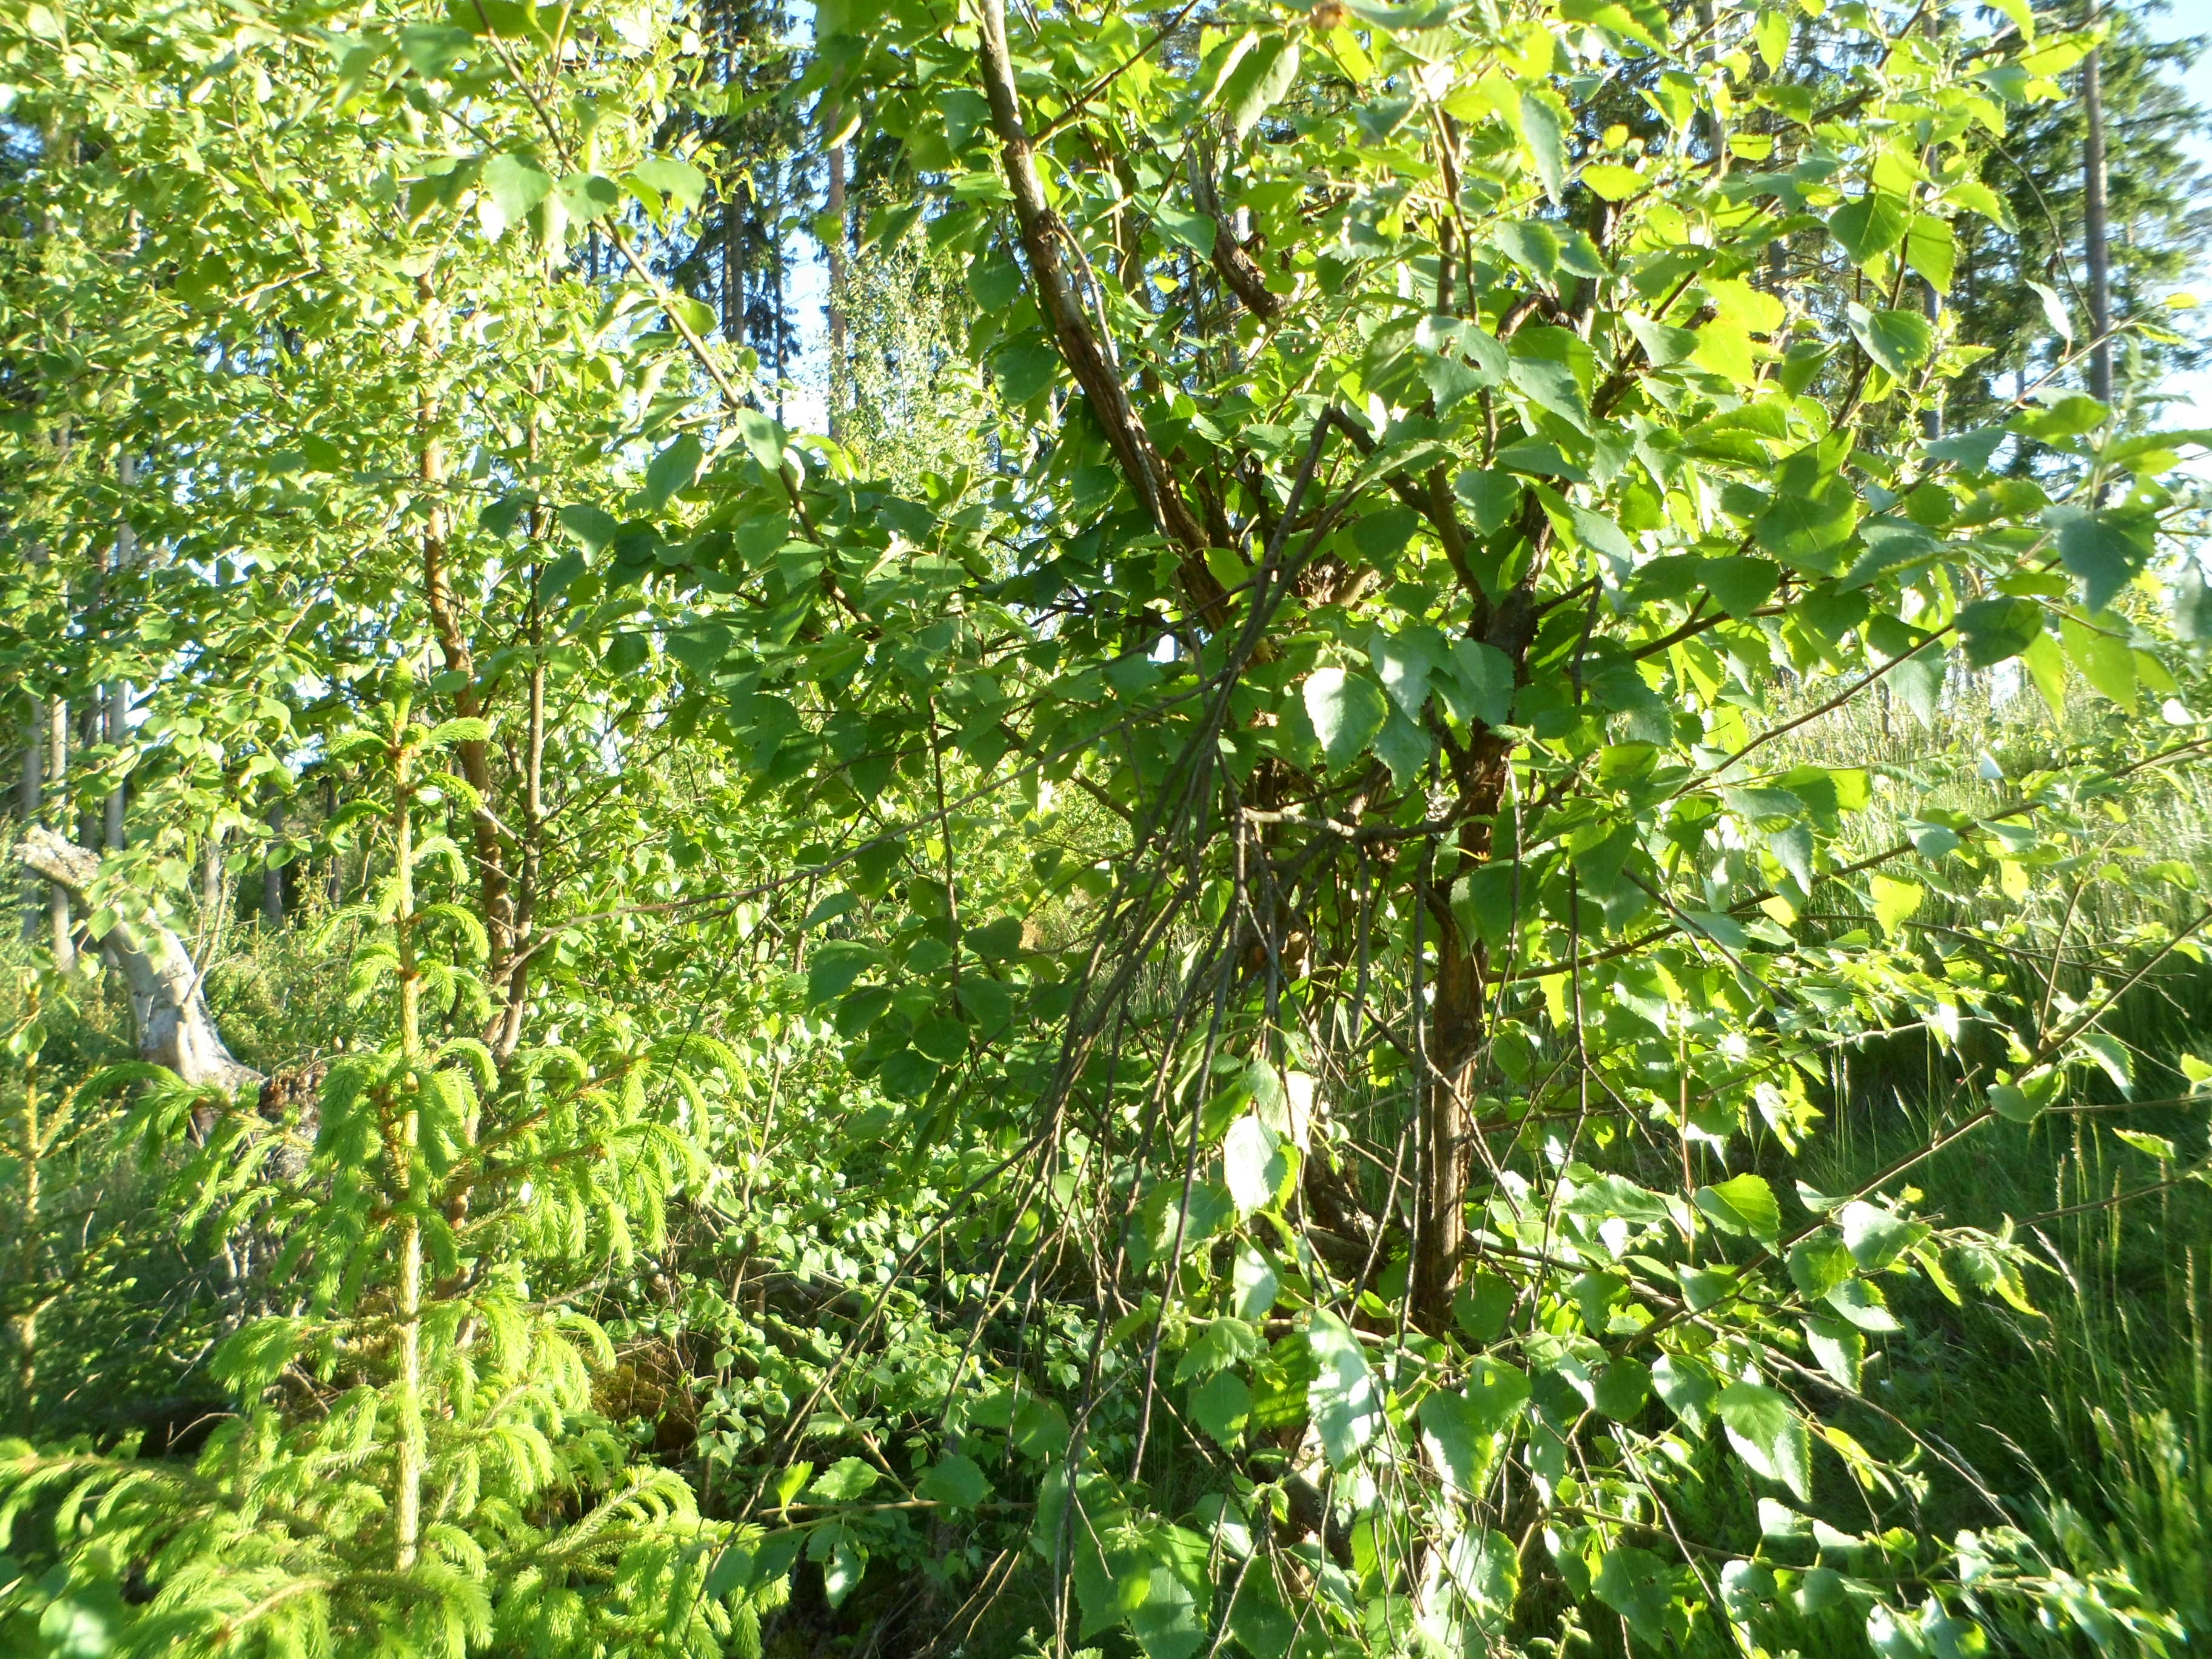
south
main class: Woodland
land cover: Spruce dominated mixed woodland
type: boreal forest
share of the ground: 50 - 75 %
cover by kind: coniferous forest trees 25 %, broadleaved forest trees 25 %, herbaceous plants 25 %, shrubs 20 %, lichens and mosses 5 %
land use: Forestry
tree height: < 5 m
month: June
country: SE
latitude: 57.4701
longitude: 14.1806
